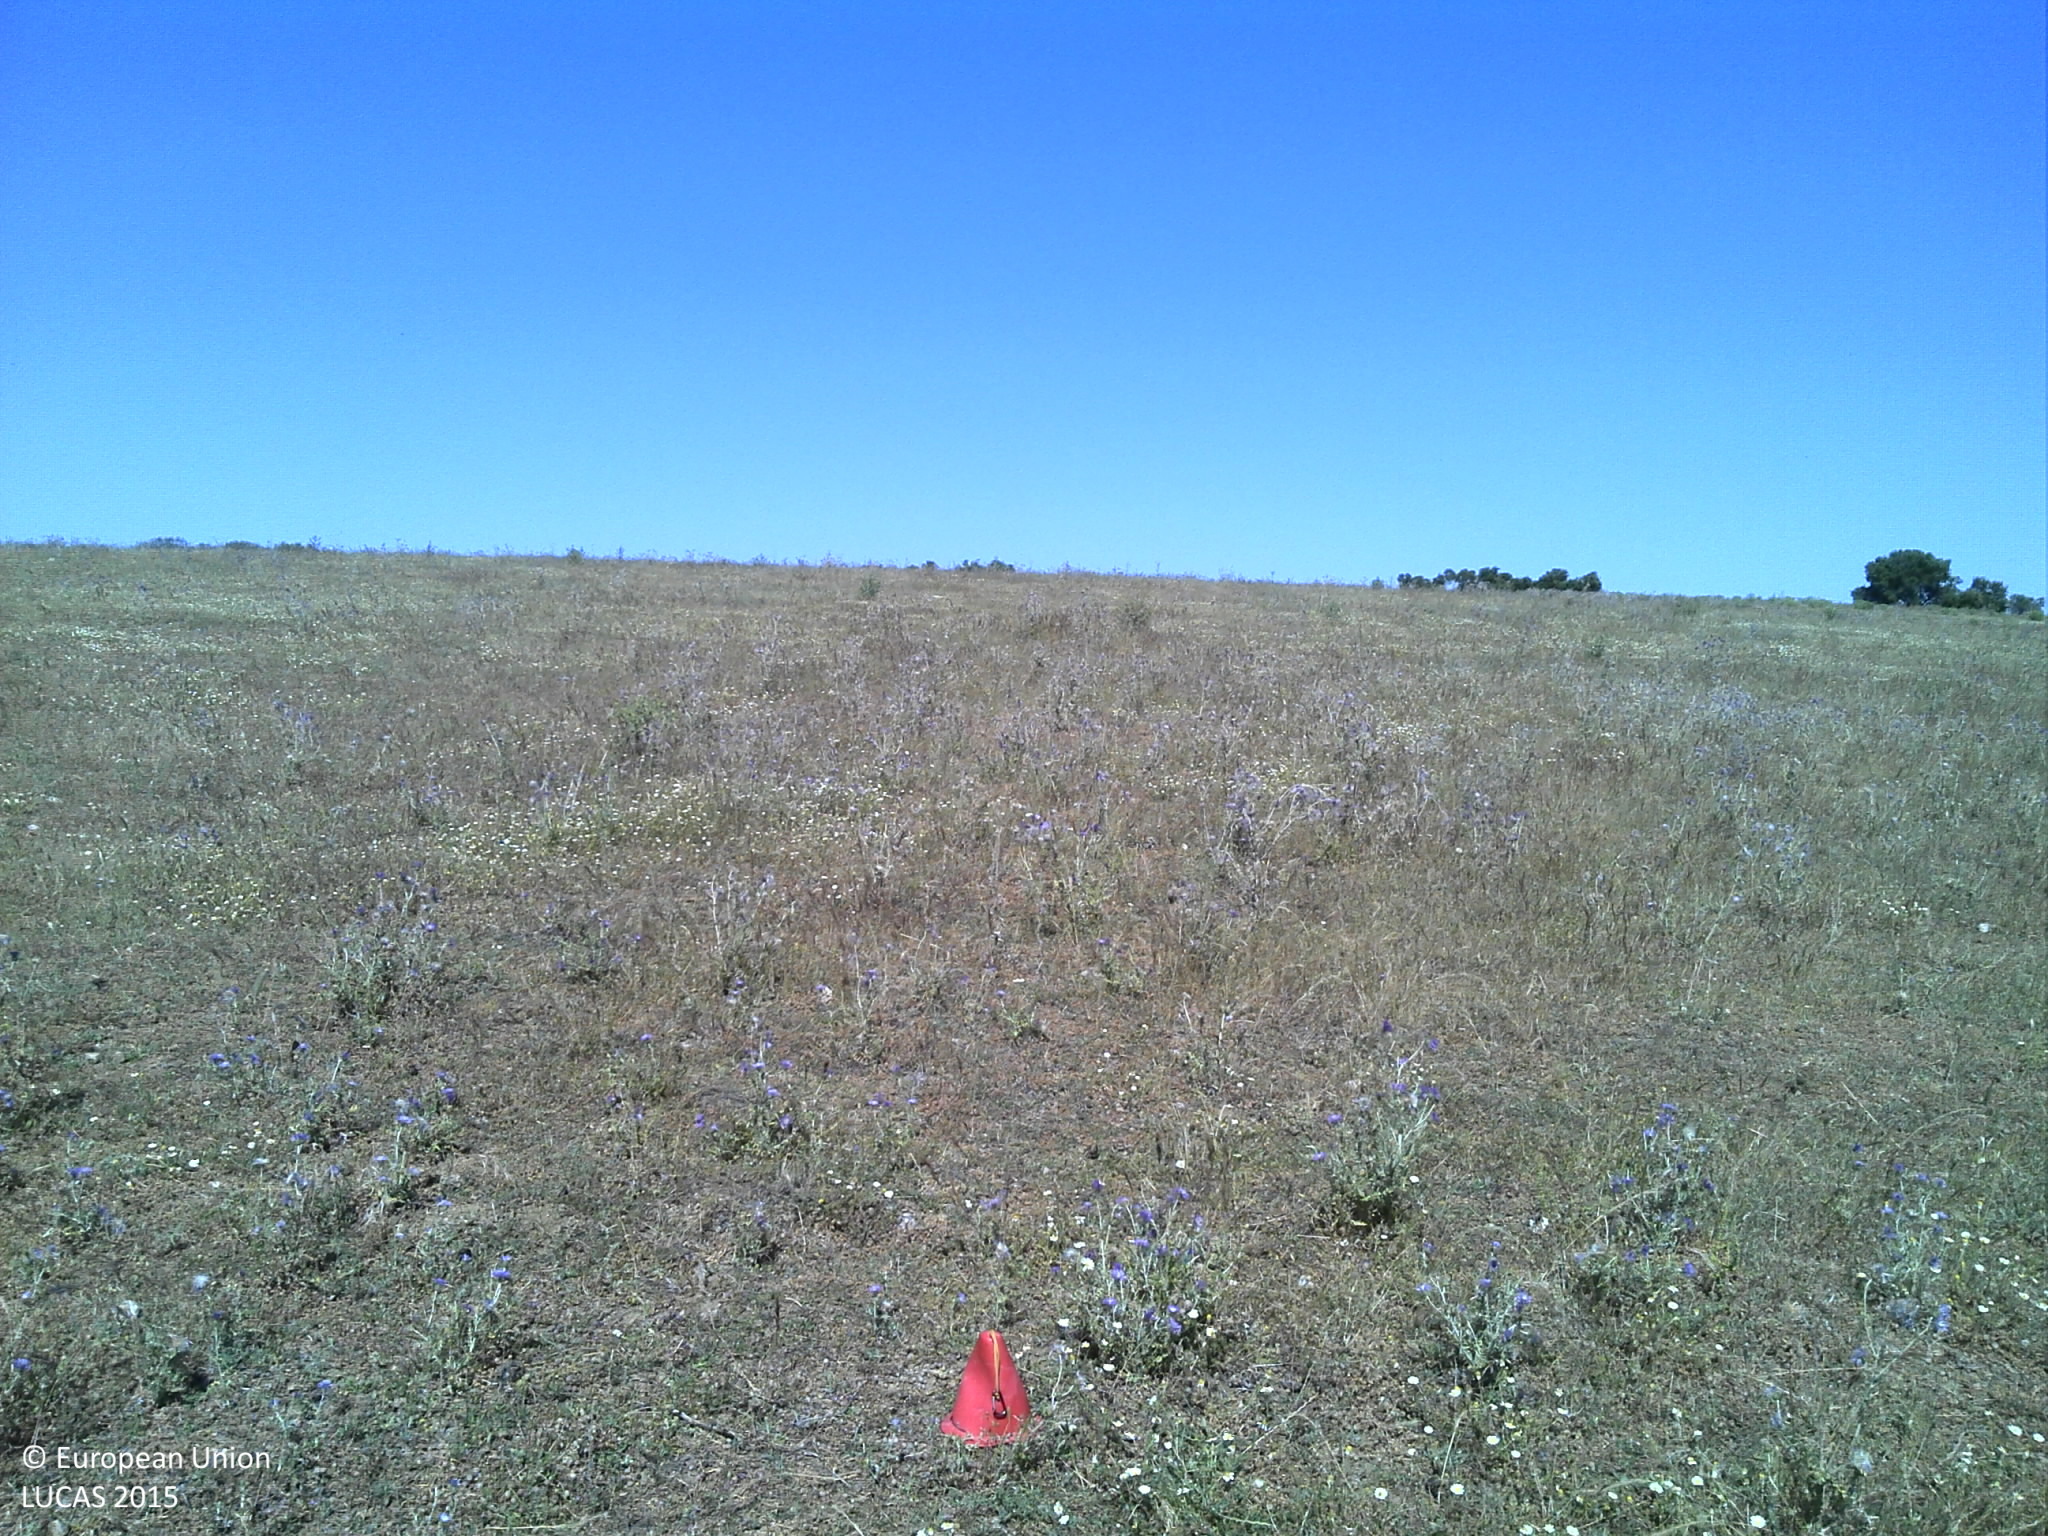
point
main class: Grassland
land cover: Spontaneously vegetated surfaces
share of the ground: 50 - 75 %
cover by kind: herbaceous plants 75 %, unconsolidated bare surface 25 %
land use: Agriculture (excluding fallow land and kitchen gardens)
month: May
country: PT
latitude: 38.8846
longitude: -7.5950
